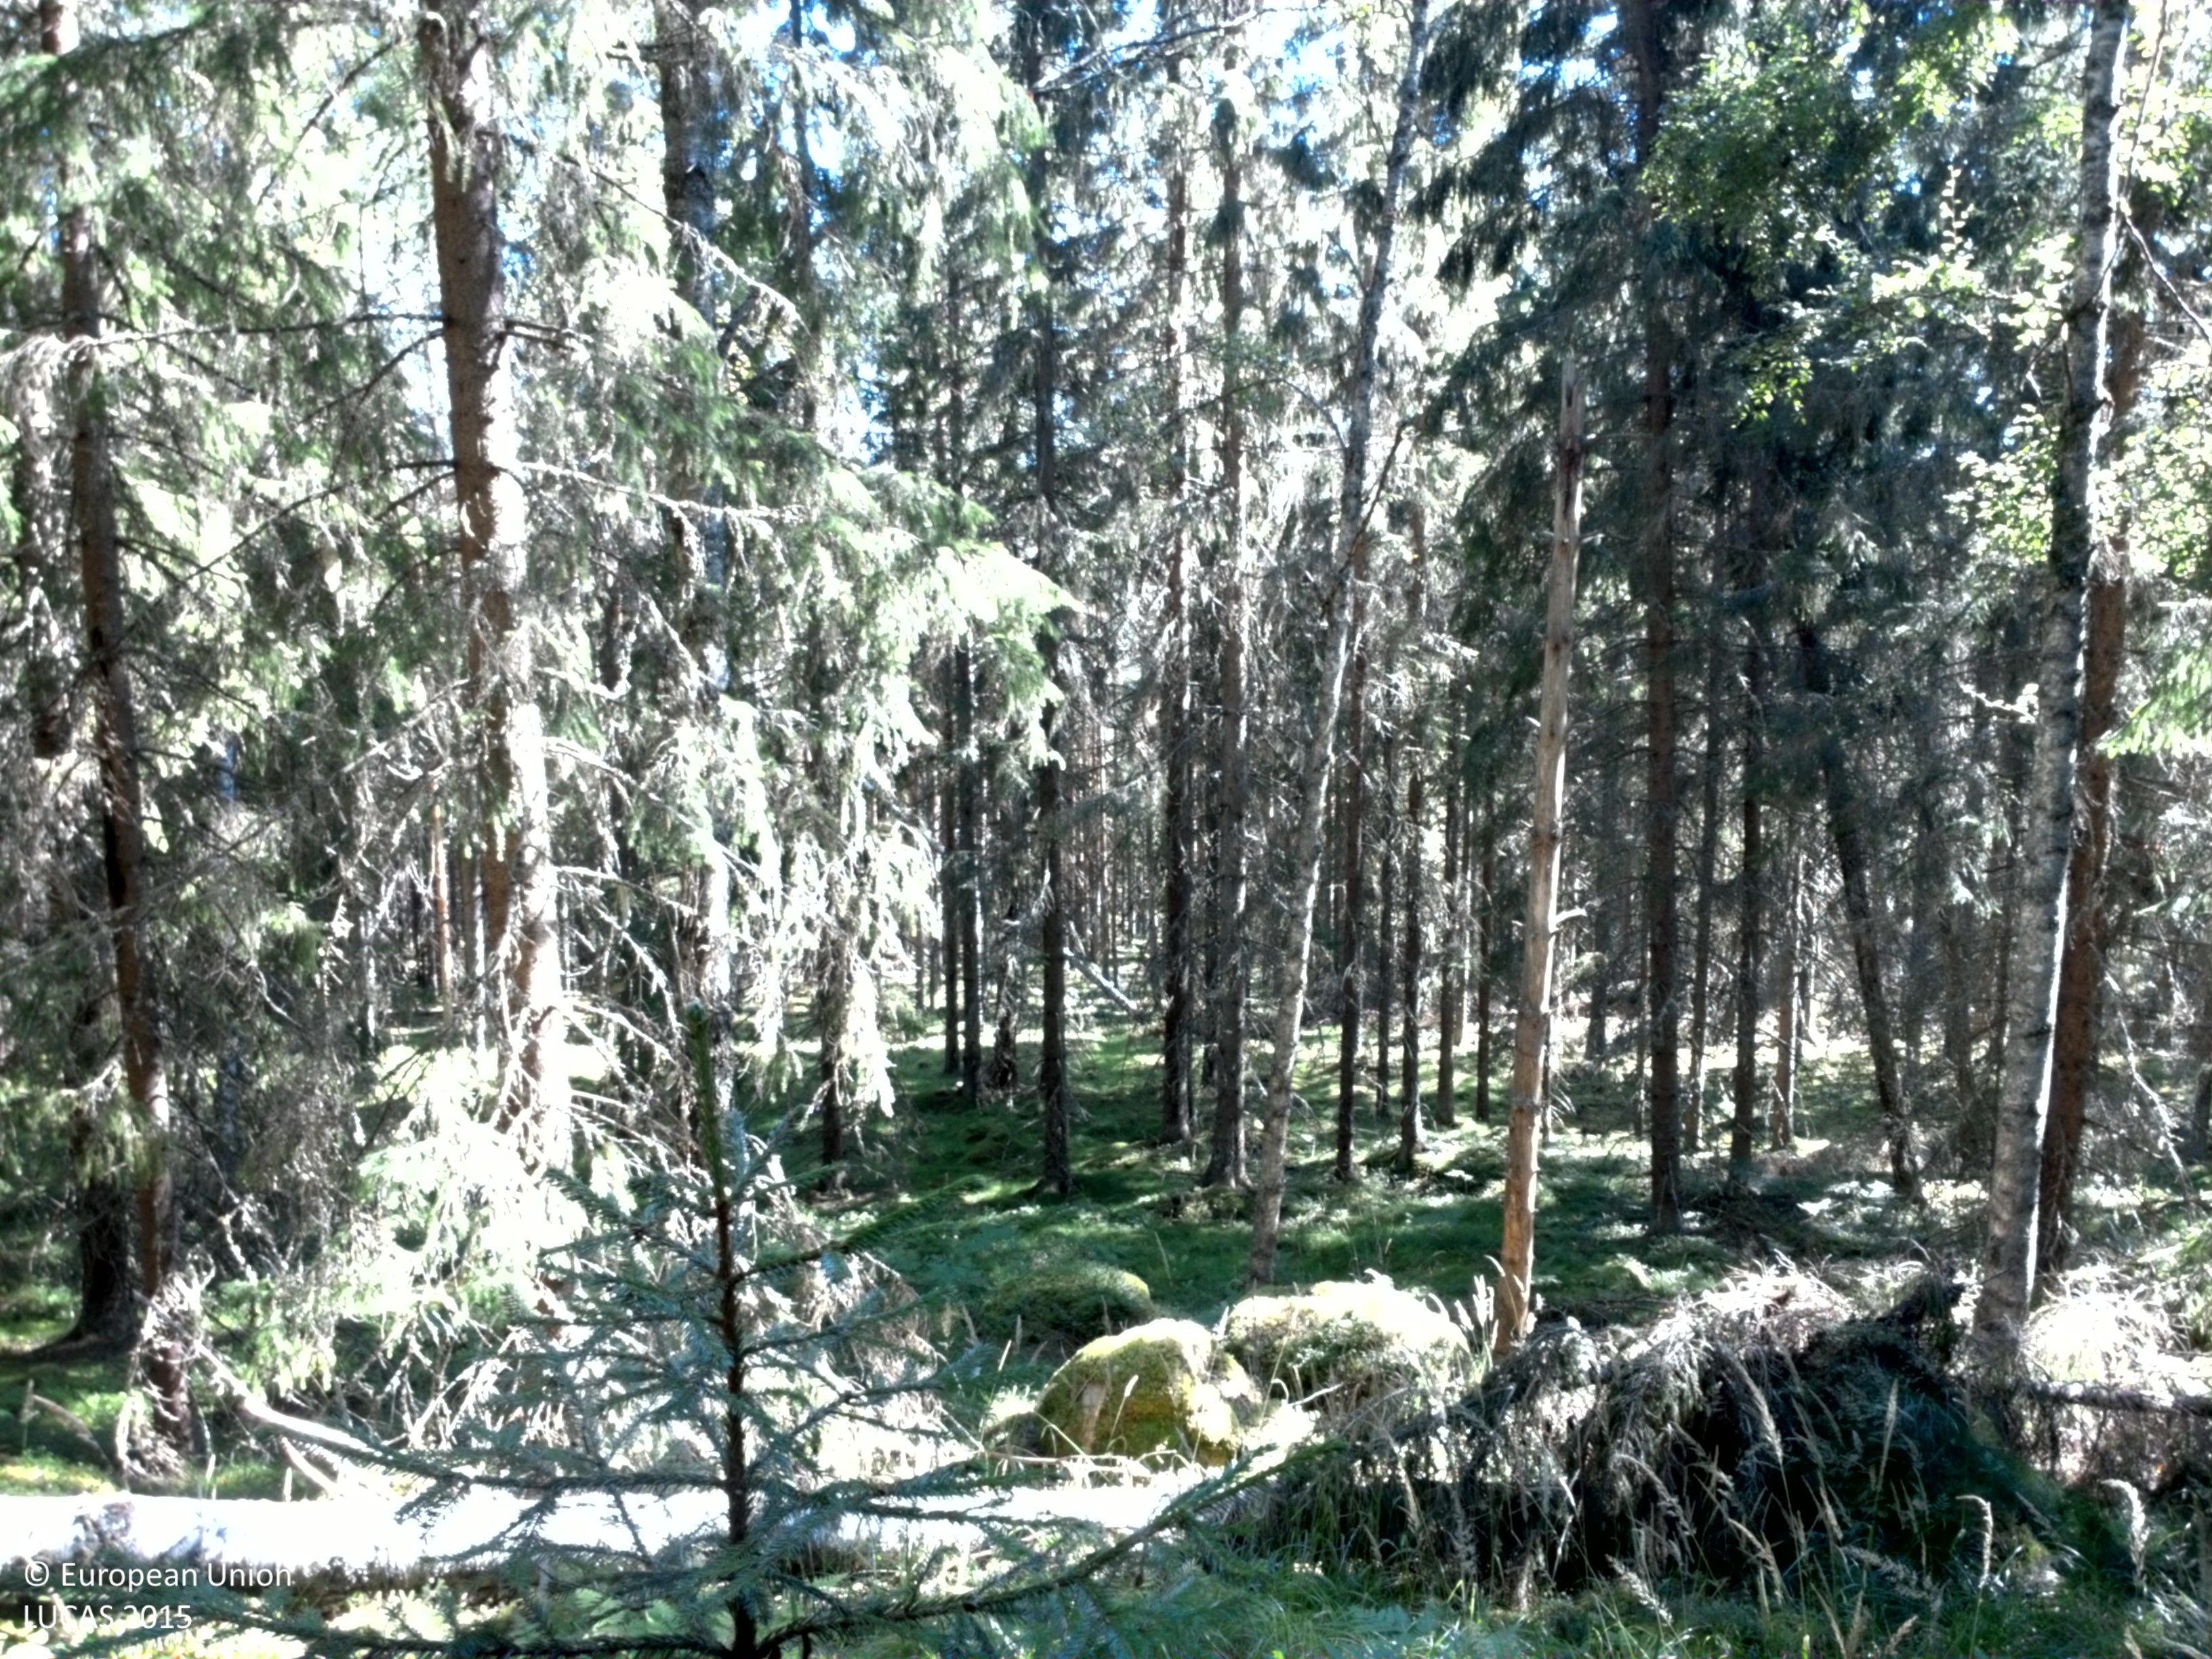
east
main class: Woodland
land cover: Spruce dominated coniferous woodland
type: boreal forest
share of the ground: 50 - 75 %
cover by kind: coniferous forest trees 65 %, lichens and mosses 15 %, shrubs 10 %, broadleaved forest trees 5 %, herbaceous plants 5 %
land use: Forestry
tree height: > 5 m
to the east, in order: Spruce dominated coniferous woodland; Pine dominated coniferous woodland; Spruce dominated coniferous woodland; Pine dominated coniferous woodland; Spruce dominated coniferous woodland; Spruce dominated mixed woodland
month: August
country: SE
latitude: 59.9079
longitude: 13.2993
